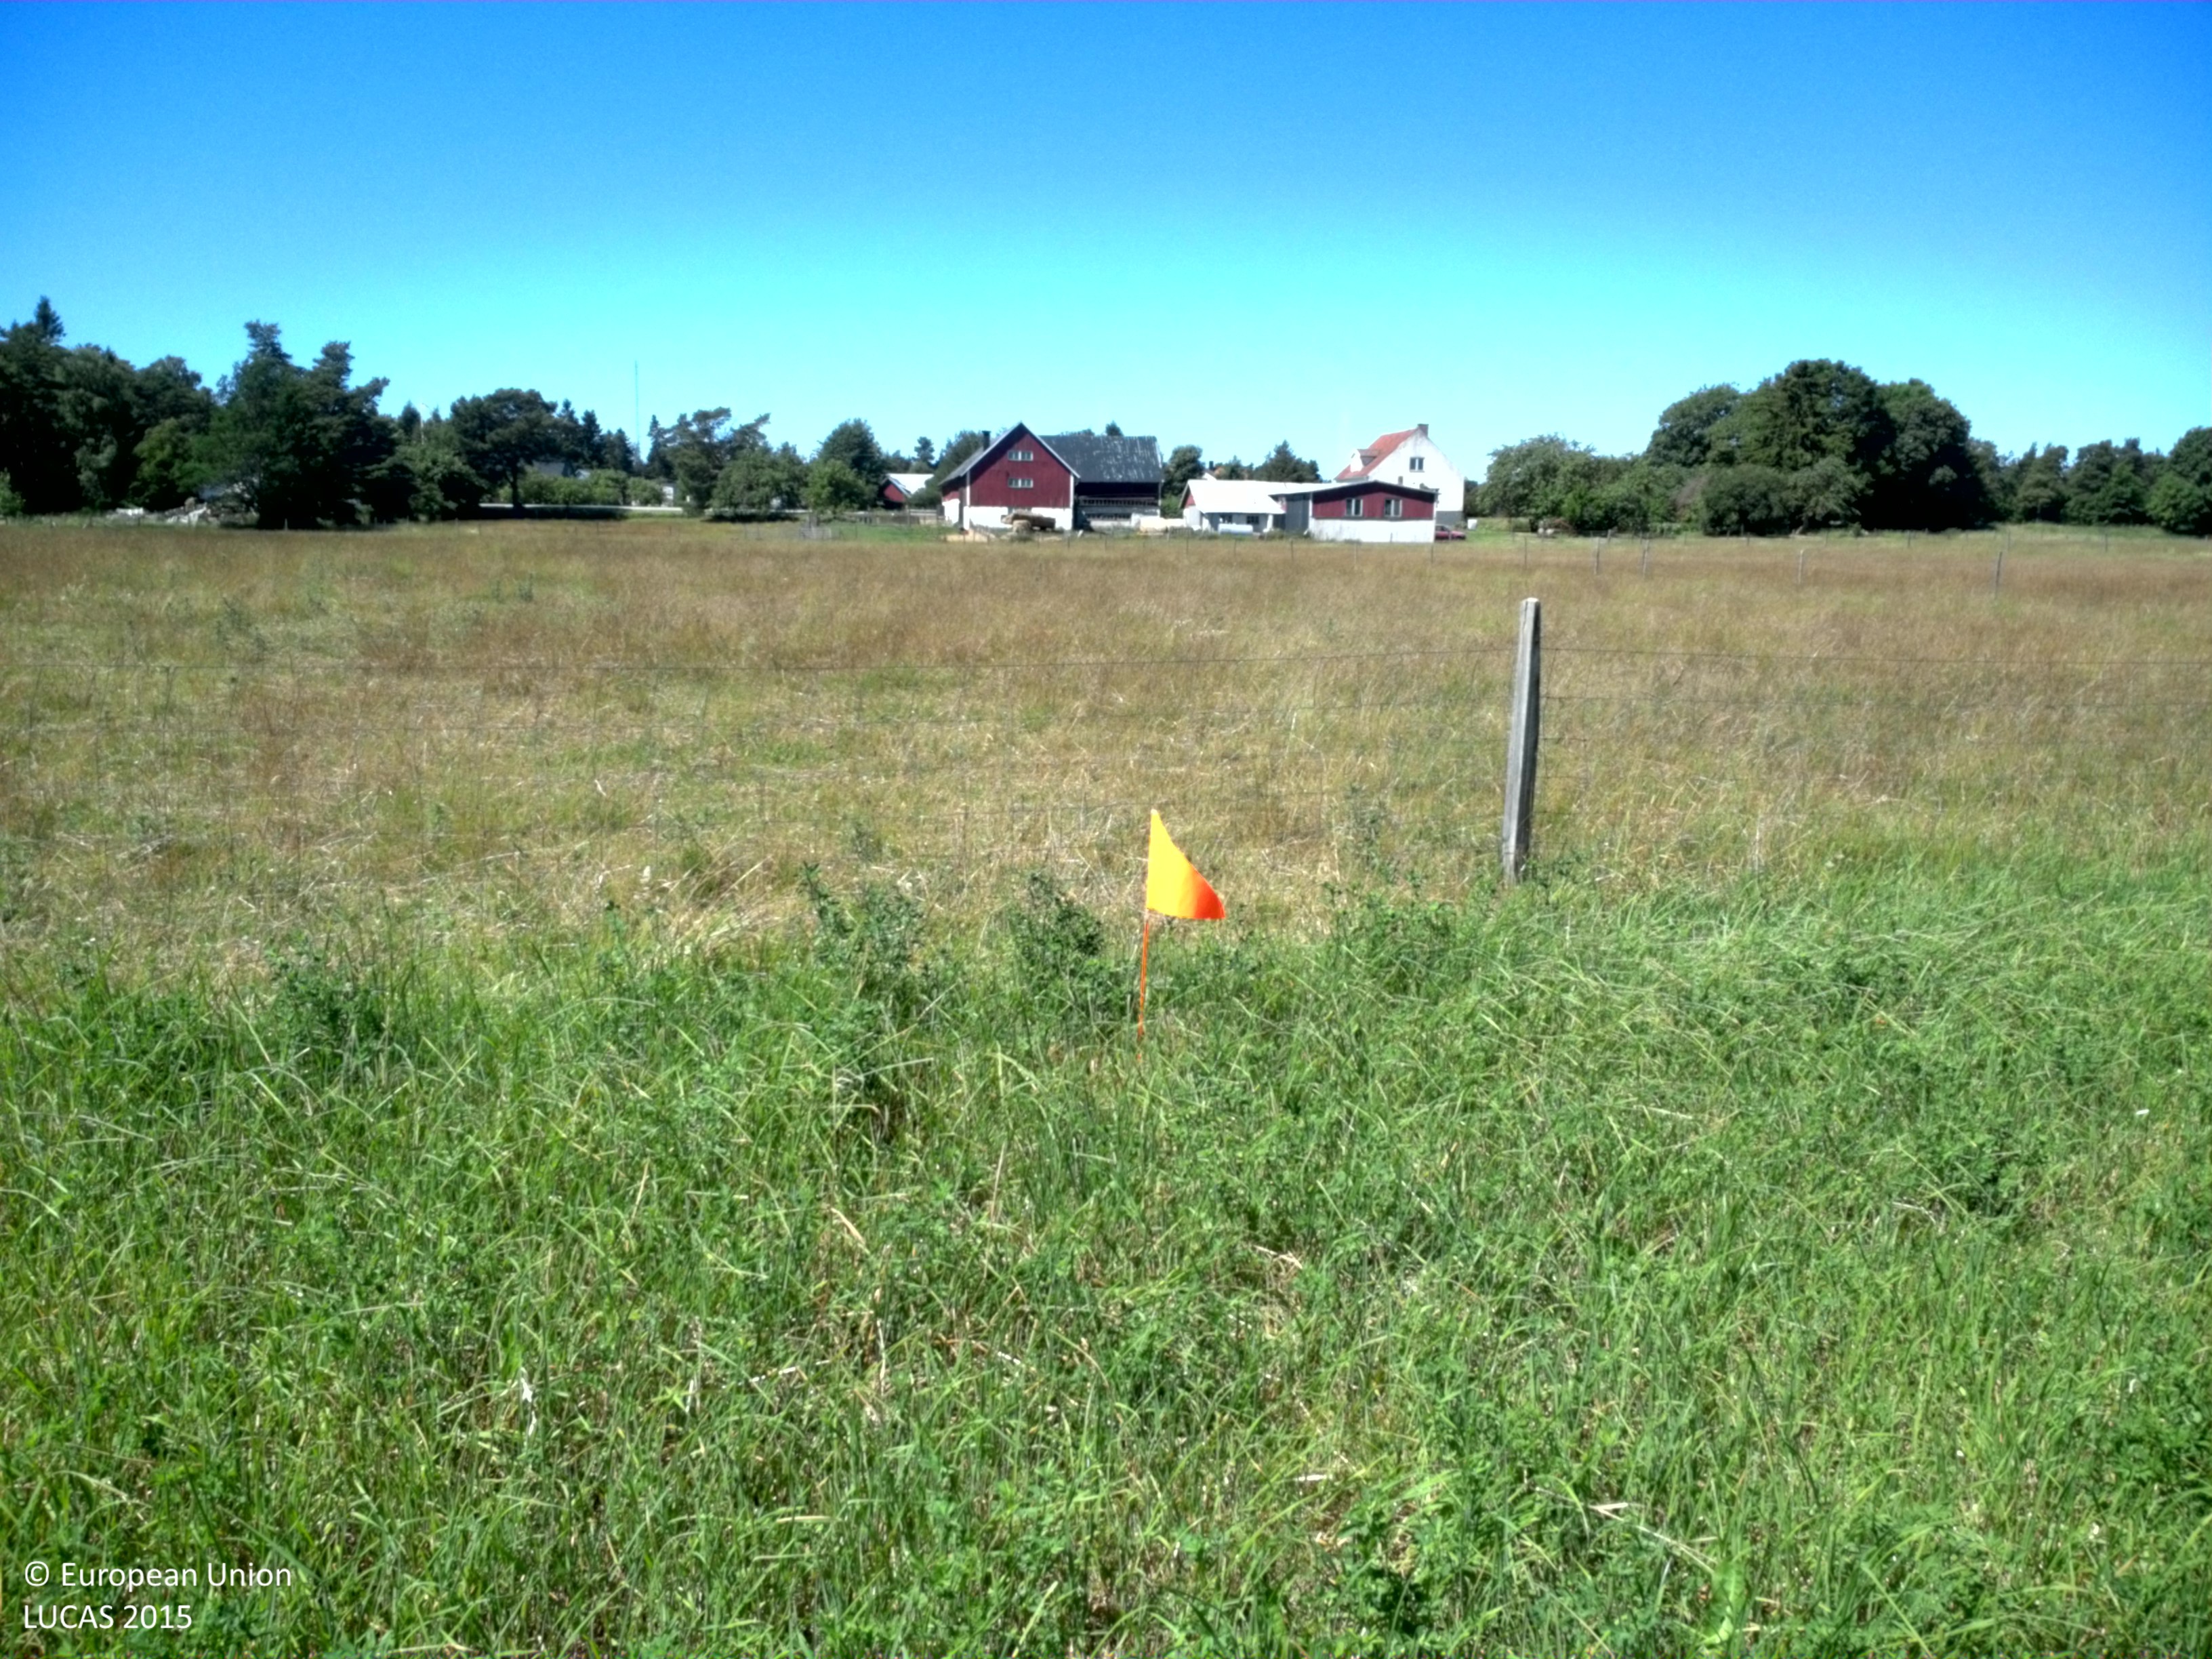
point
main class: Cropland
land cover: Lucerne
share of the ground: > 75 %
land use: Agriculture (excluding fallow land and kitchen gardens)
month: July
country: SE
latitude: 57.7541
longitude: 18.7306
